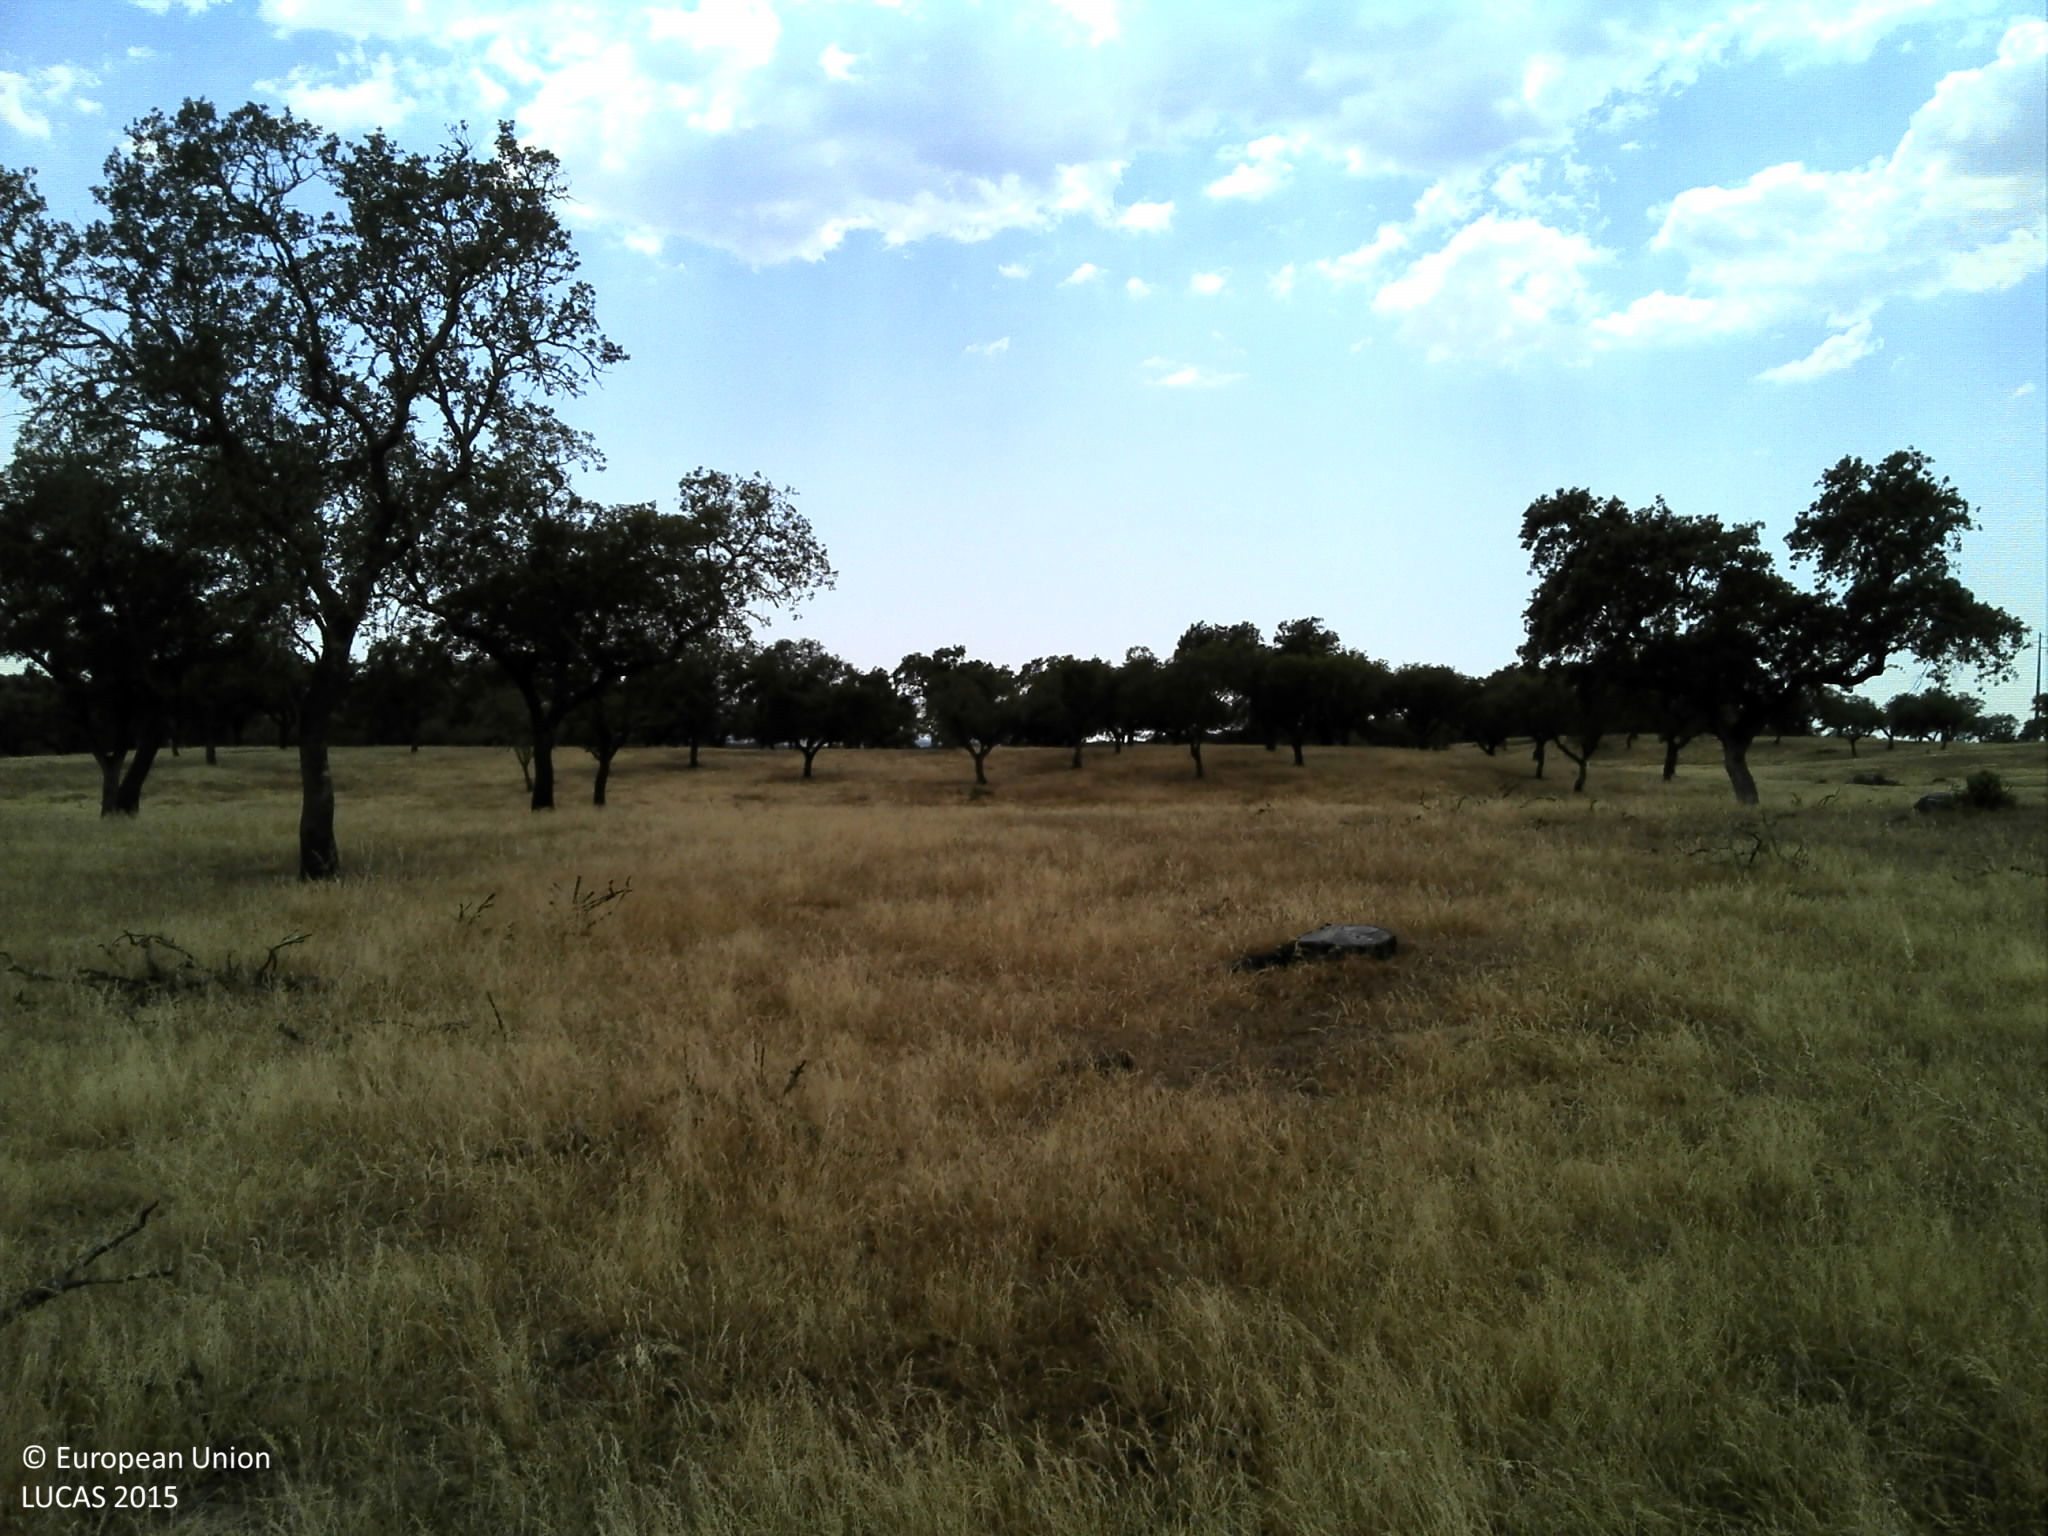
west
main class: Woodland
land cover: Broadleaved woodland
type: broadleaved evergreen forest
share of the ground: 10 - 25 %
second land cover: Grassland without tree/shrub cover
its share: 25 - 50 %
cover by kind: herbaceous plants 50 %, broadleaved forest trees 25 %, unconsolidated bare surface 25 %
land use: Forestry
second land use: Agriculture (excluding fallow land and kitchen gardens)
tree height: > 5 m
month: May
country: PT
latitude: 38.8477
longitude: -7.8920
